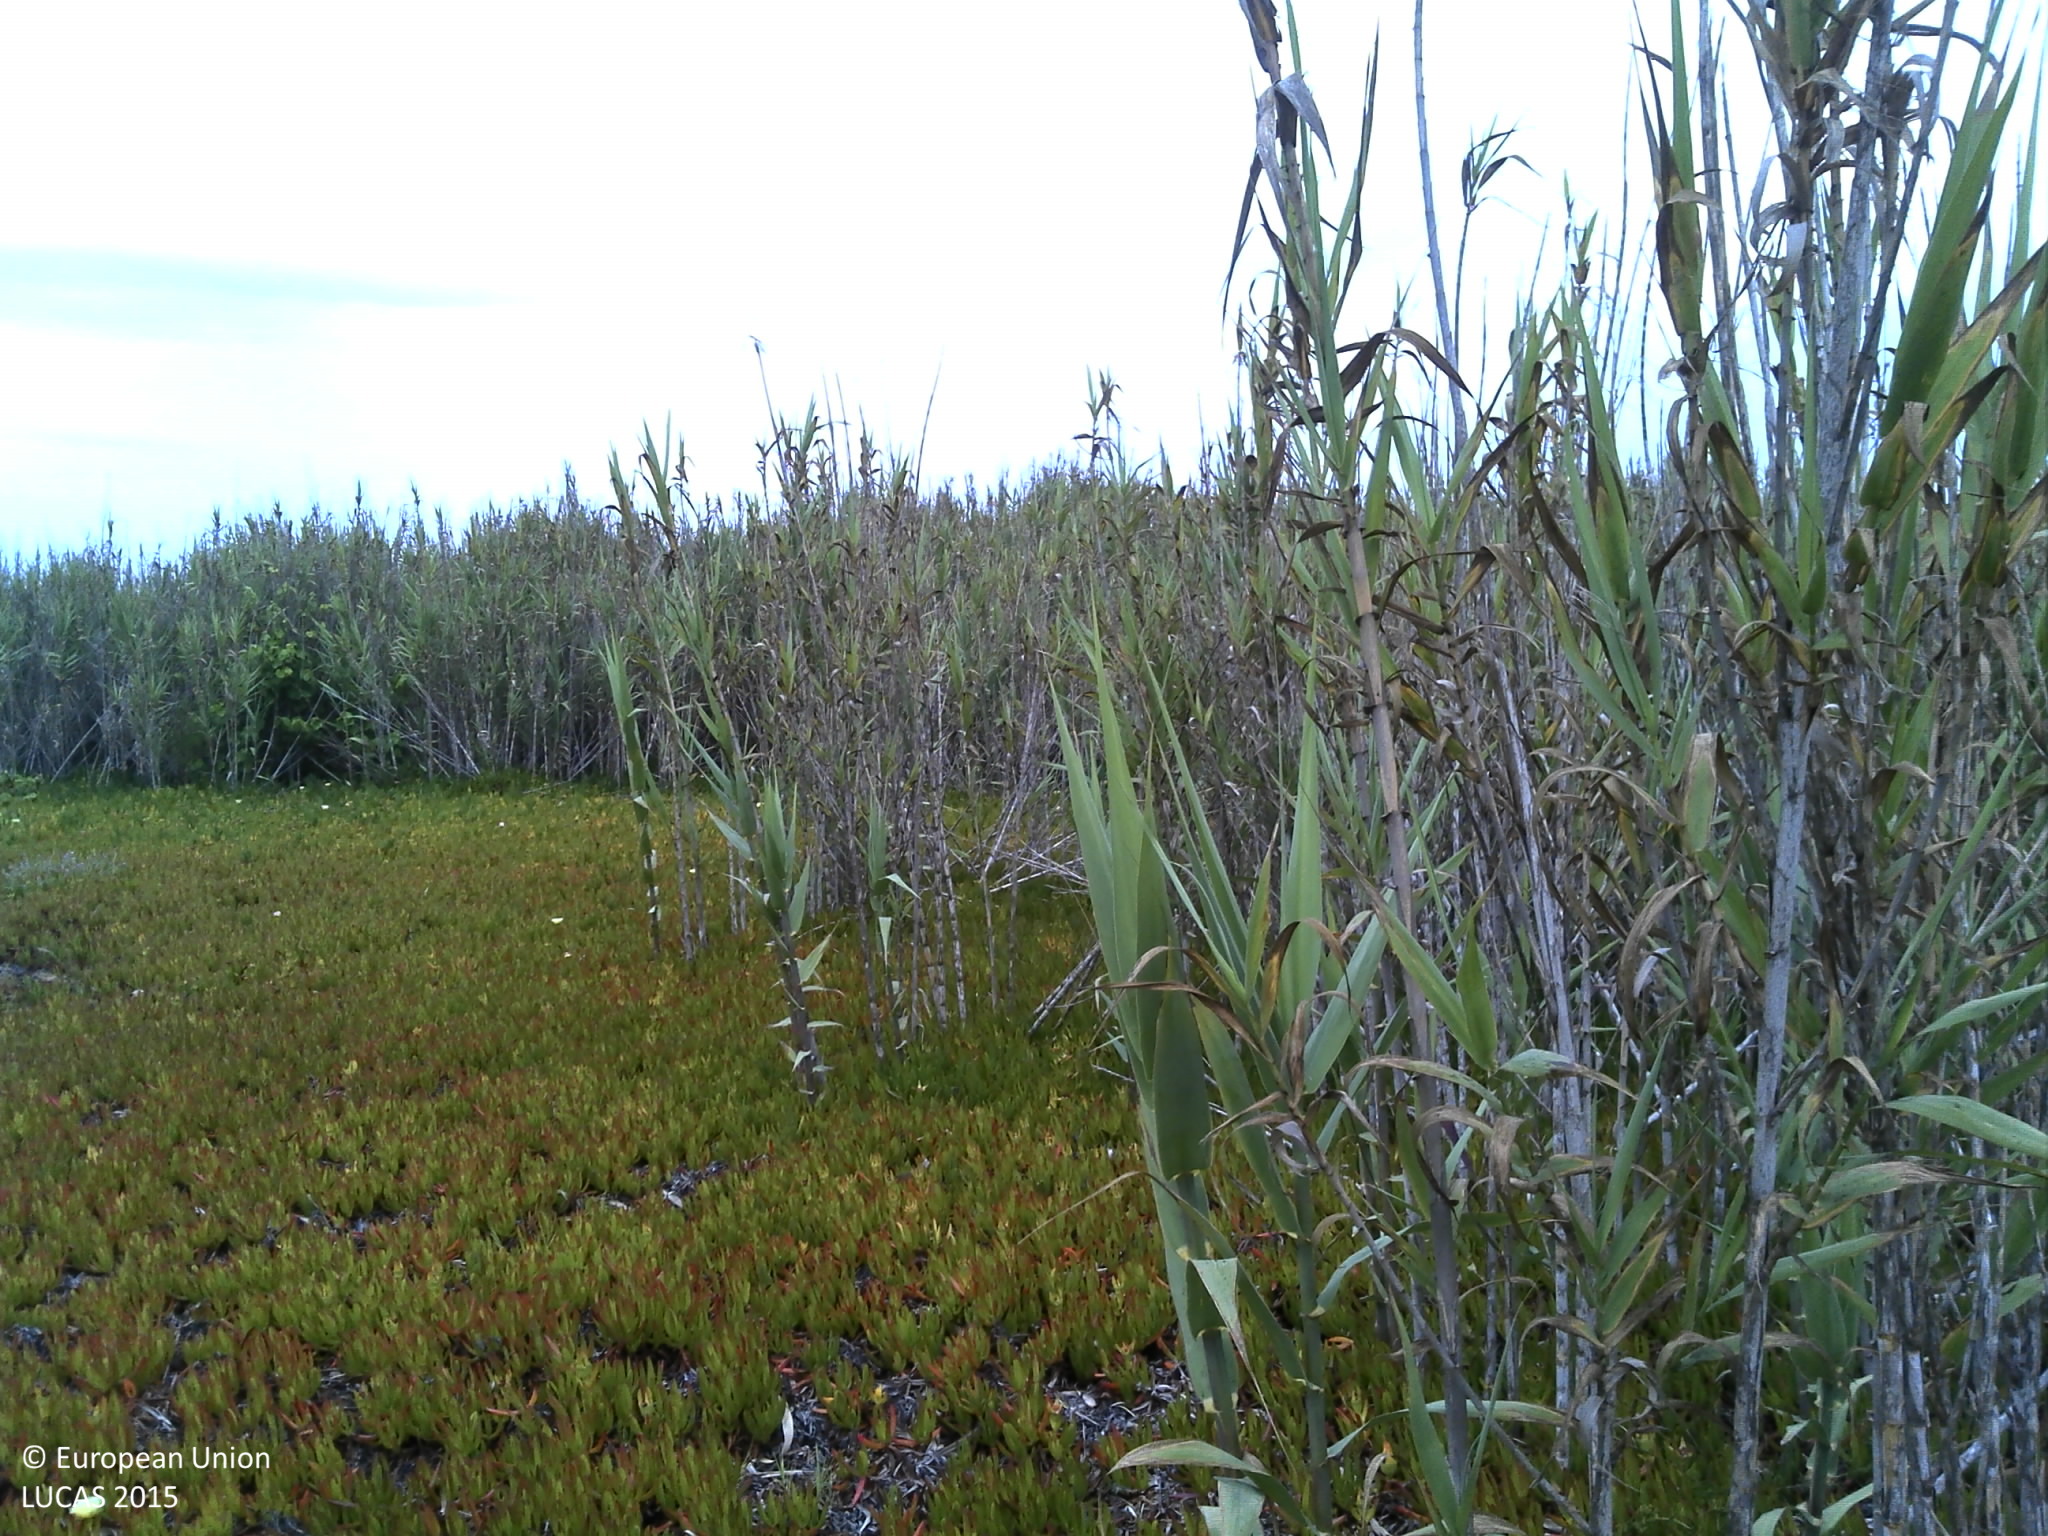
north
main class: Shrubland
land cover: Shrubland without tree cover
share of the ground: 50 - 75 %
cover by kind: shrubs 75 %, herbaceous plants 15 %, unconsolidated bare surface 10 %
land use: Semi-natural and natural areas not in use
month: June
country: PT
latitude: 39.3671
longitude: -9.3983
